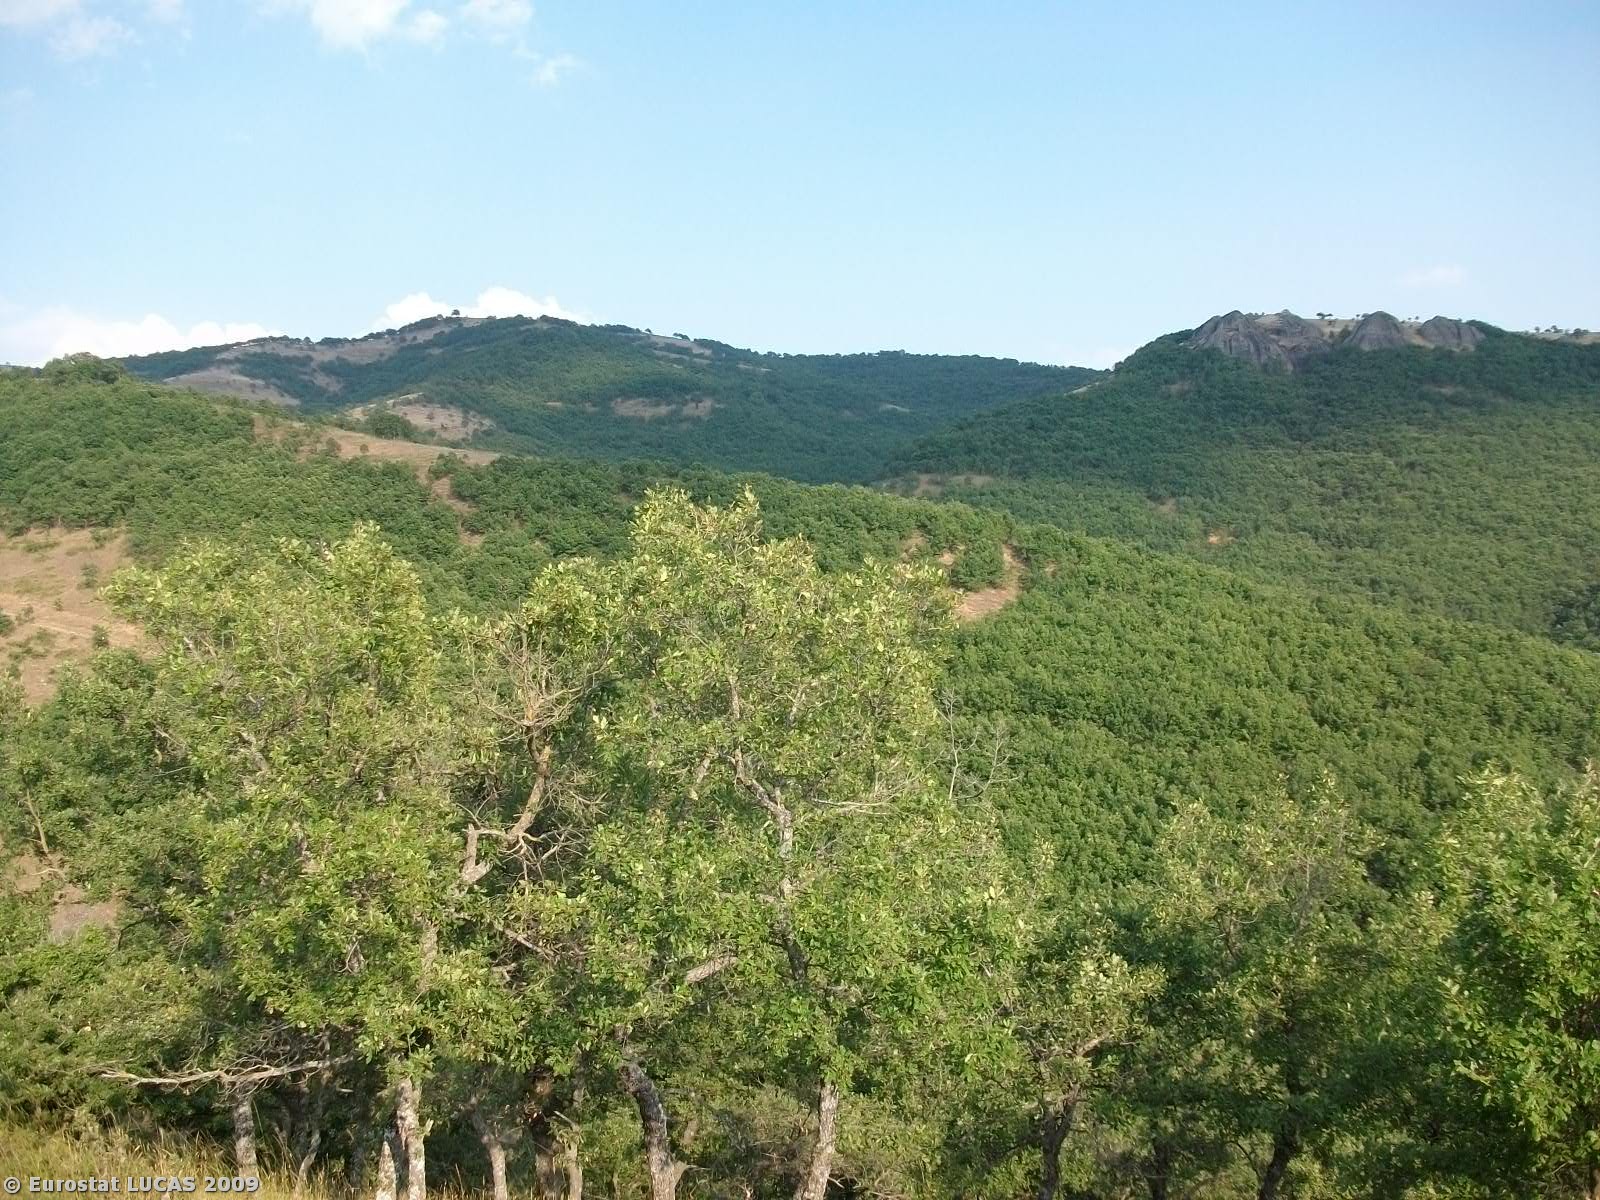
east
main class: Grassland
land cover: Grassland with sparse tree/shrub cover
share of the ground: > 75 %
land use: Unused
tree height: > 5 m
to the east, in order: Grassland with sparse tree/shrub cover; Broadleaved woodland; Rivers and streams; Broadleaved woodland; Tracks
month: August
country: GR
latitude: 39.7541
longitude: 21.6445
